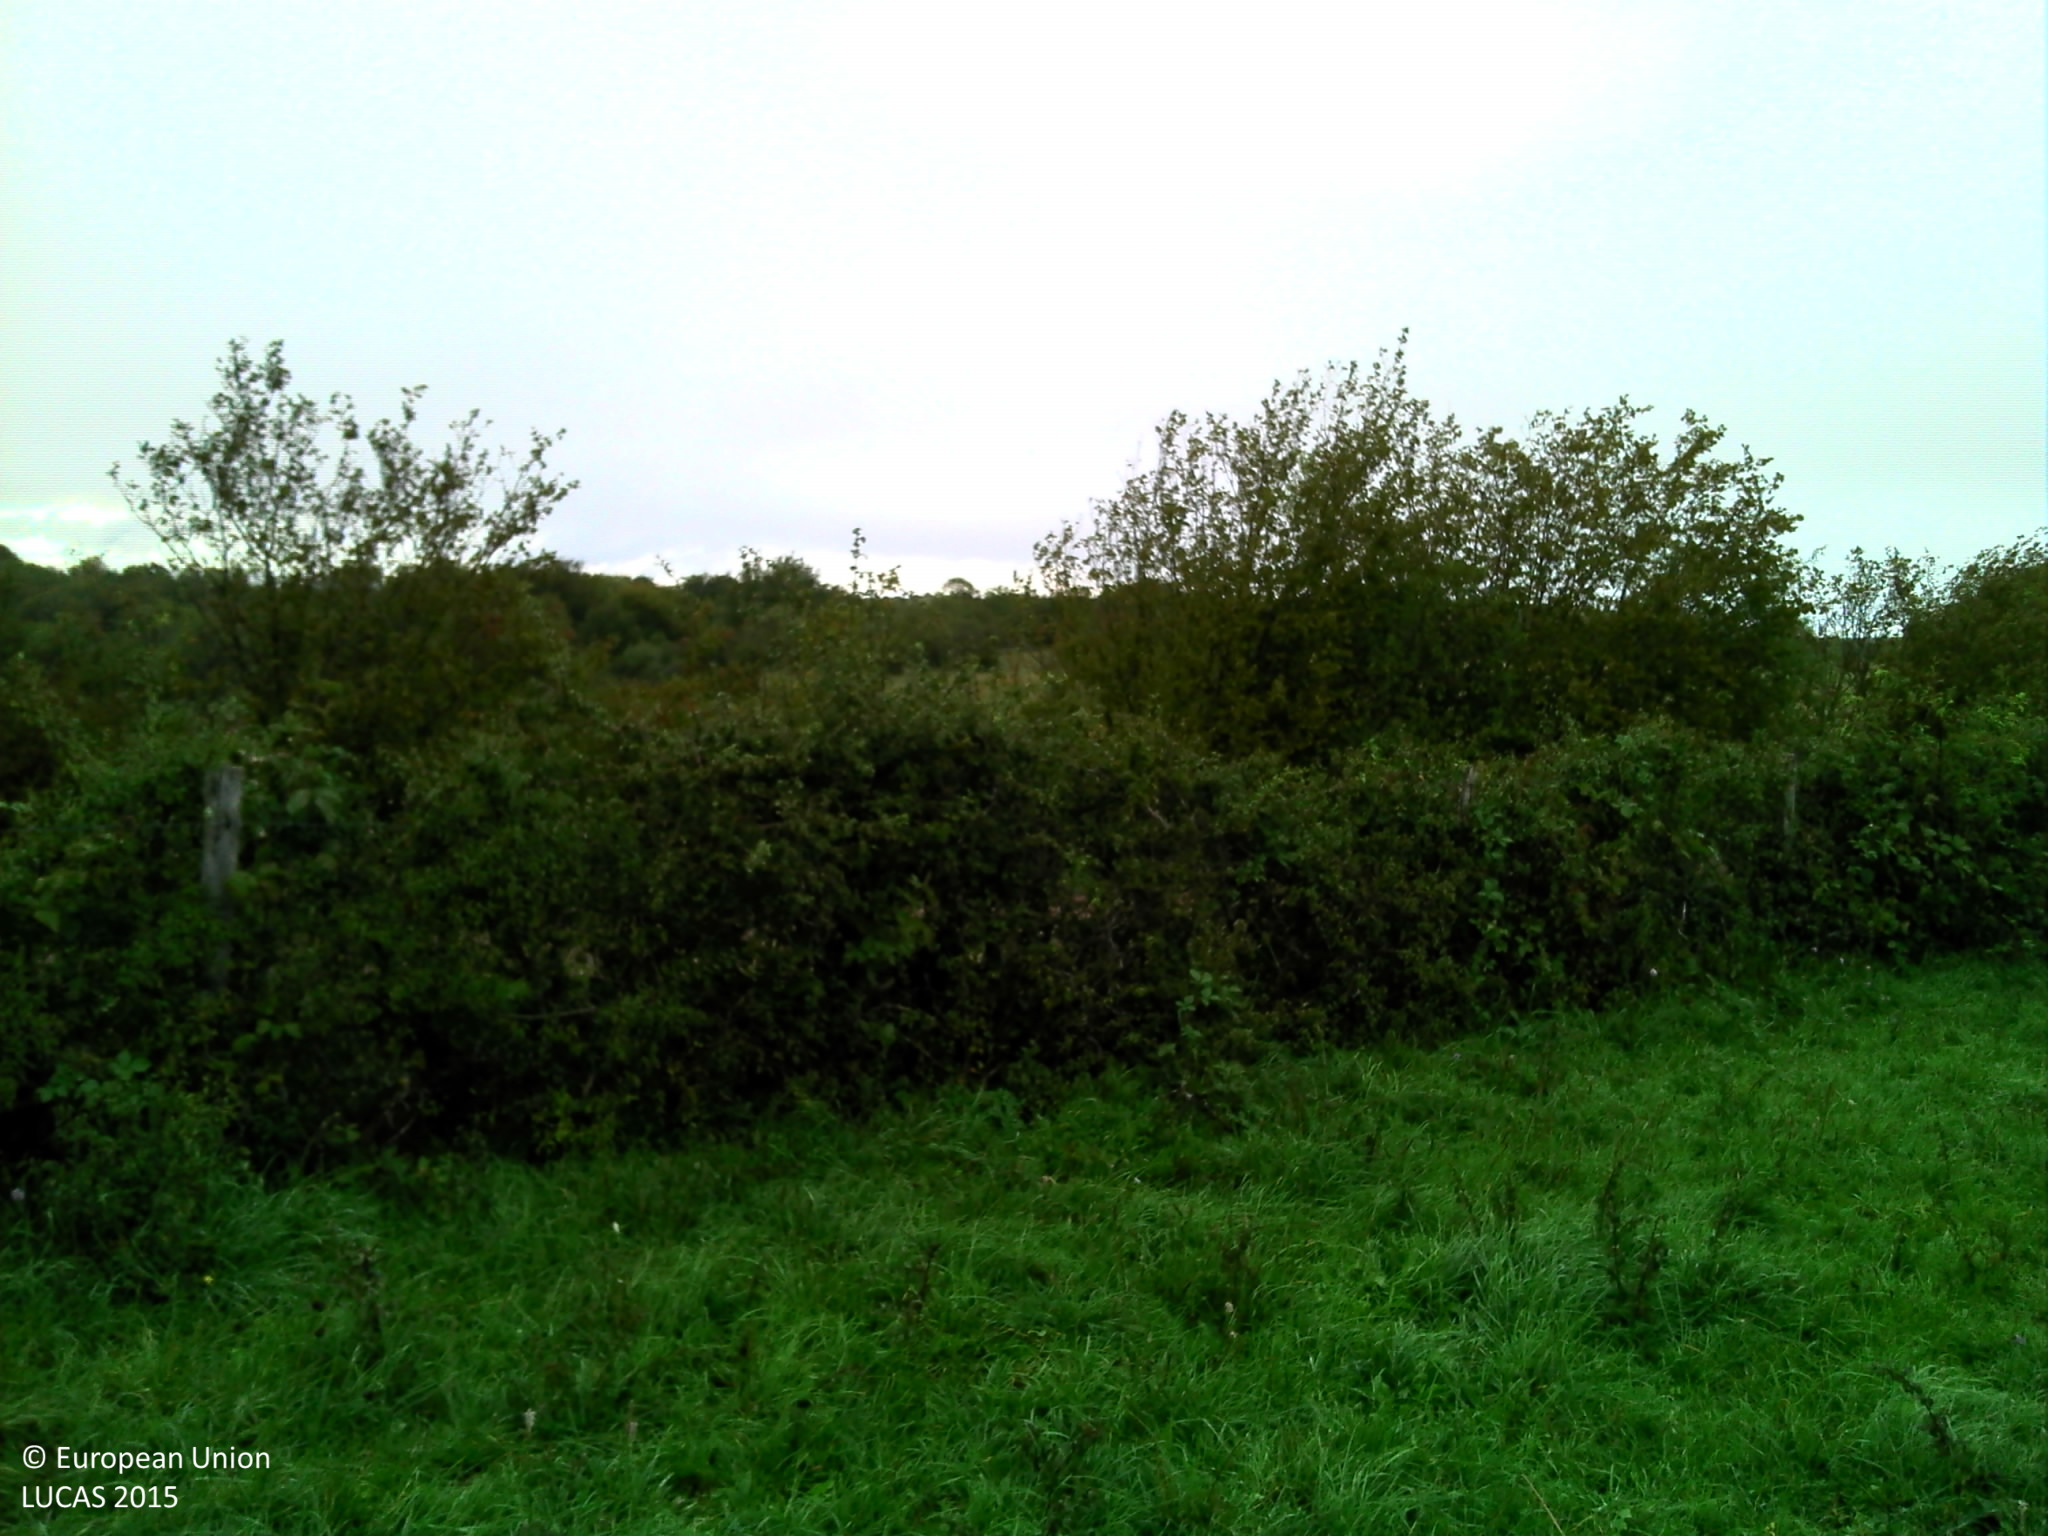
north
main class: Grassland
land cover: Grassland without tree/shrub cover
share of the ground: > 75 %
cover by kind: herbaceous plants 100 %
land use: Agriculture (excluding fallow land and kitchen gardens)
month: September
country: FR
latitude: 47.1241
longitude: 4.7409
